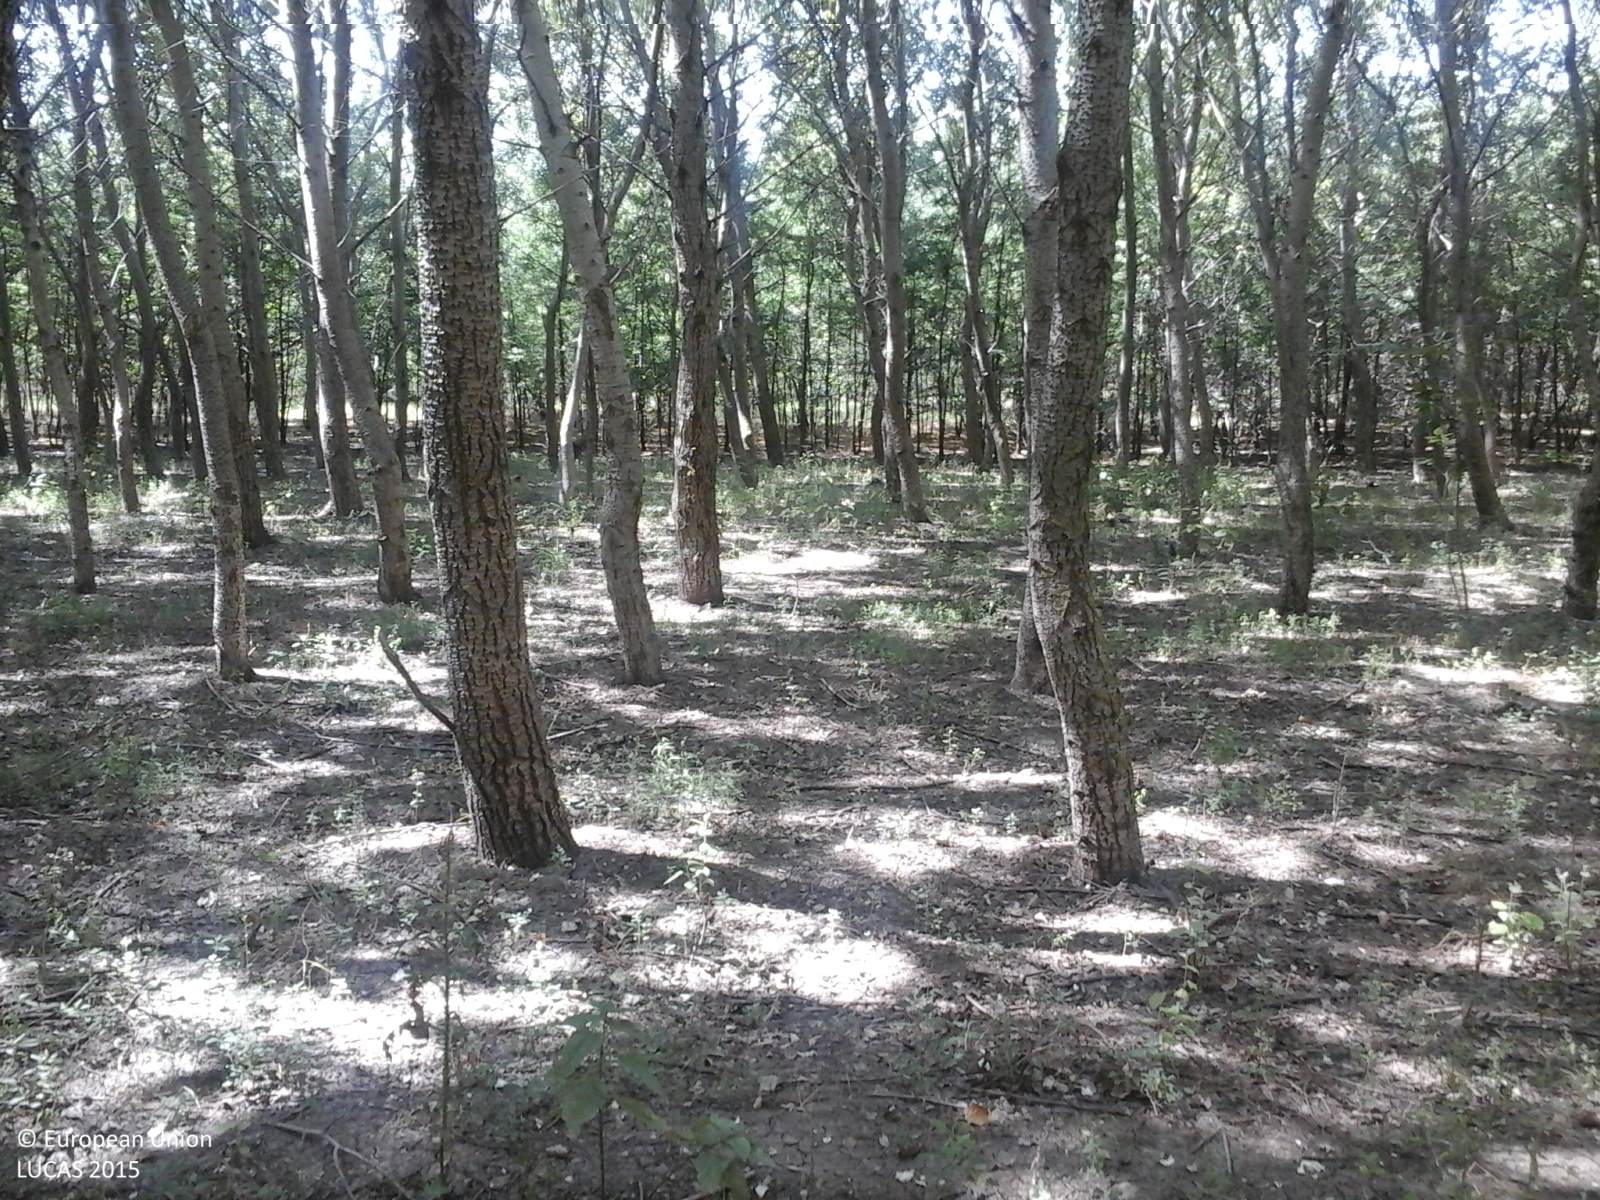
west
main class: Woodland
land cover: Broadleaved woodland
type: acidophilous oak and oak-birch forest
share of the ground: > 75 %
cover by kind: broadleaved forest trees 100 %
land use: Forestry
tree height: > 5 m
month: August
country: RO
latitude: 44.5549
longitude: 28.1787
